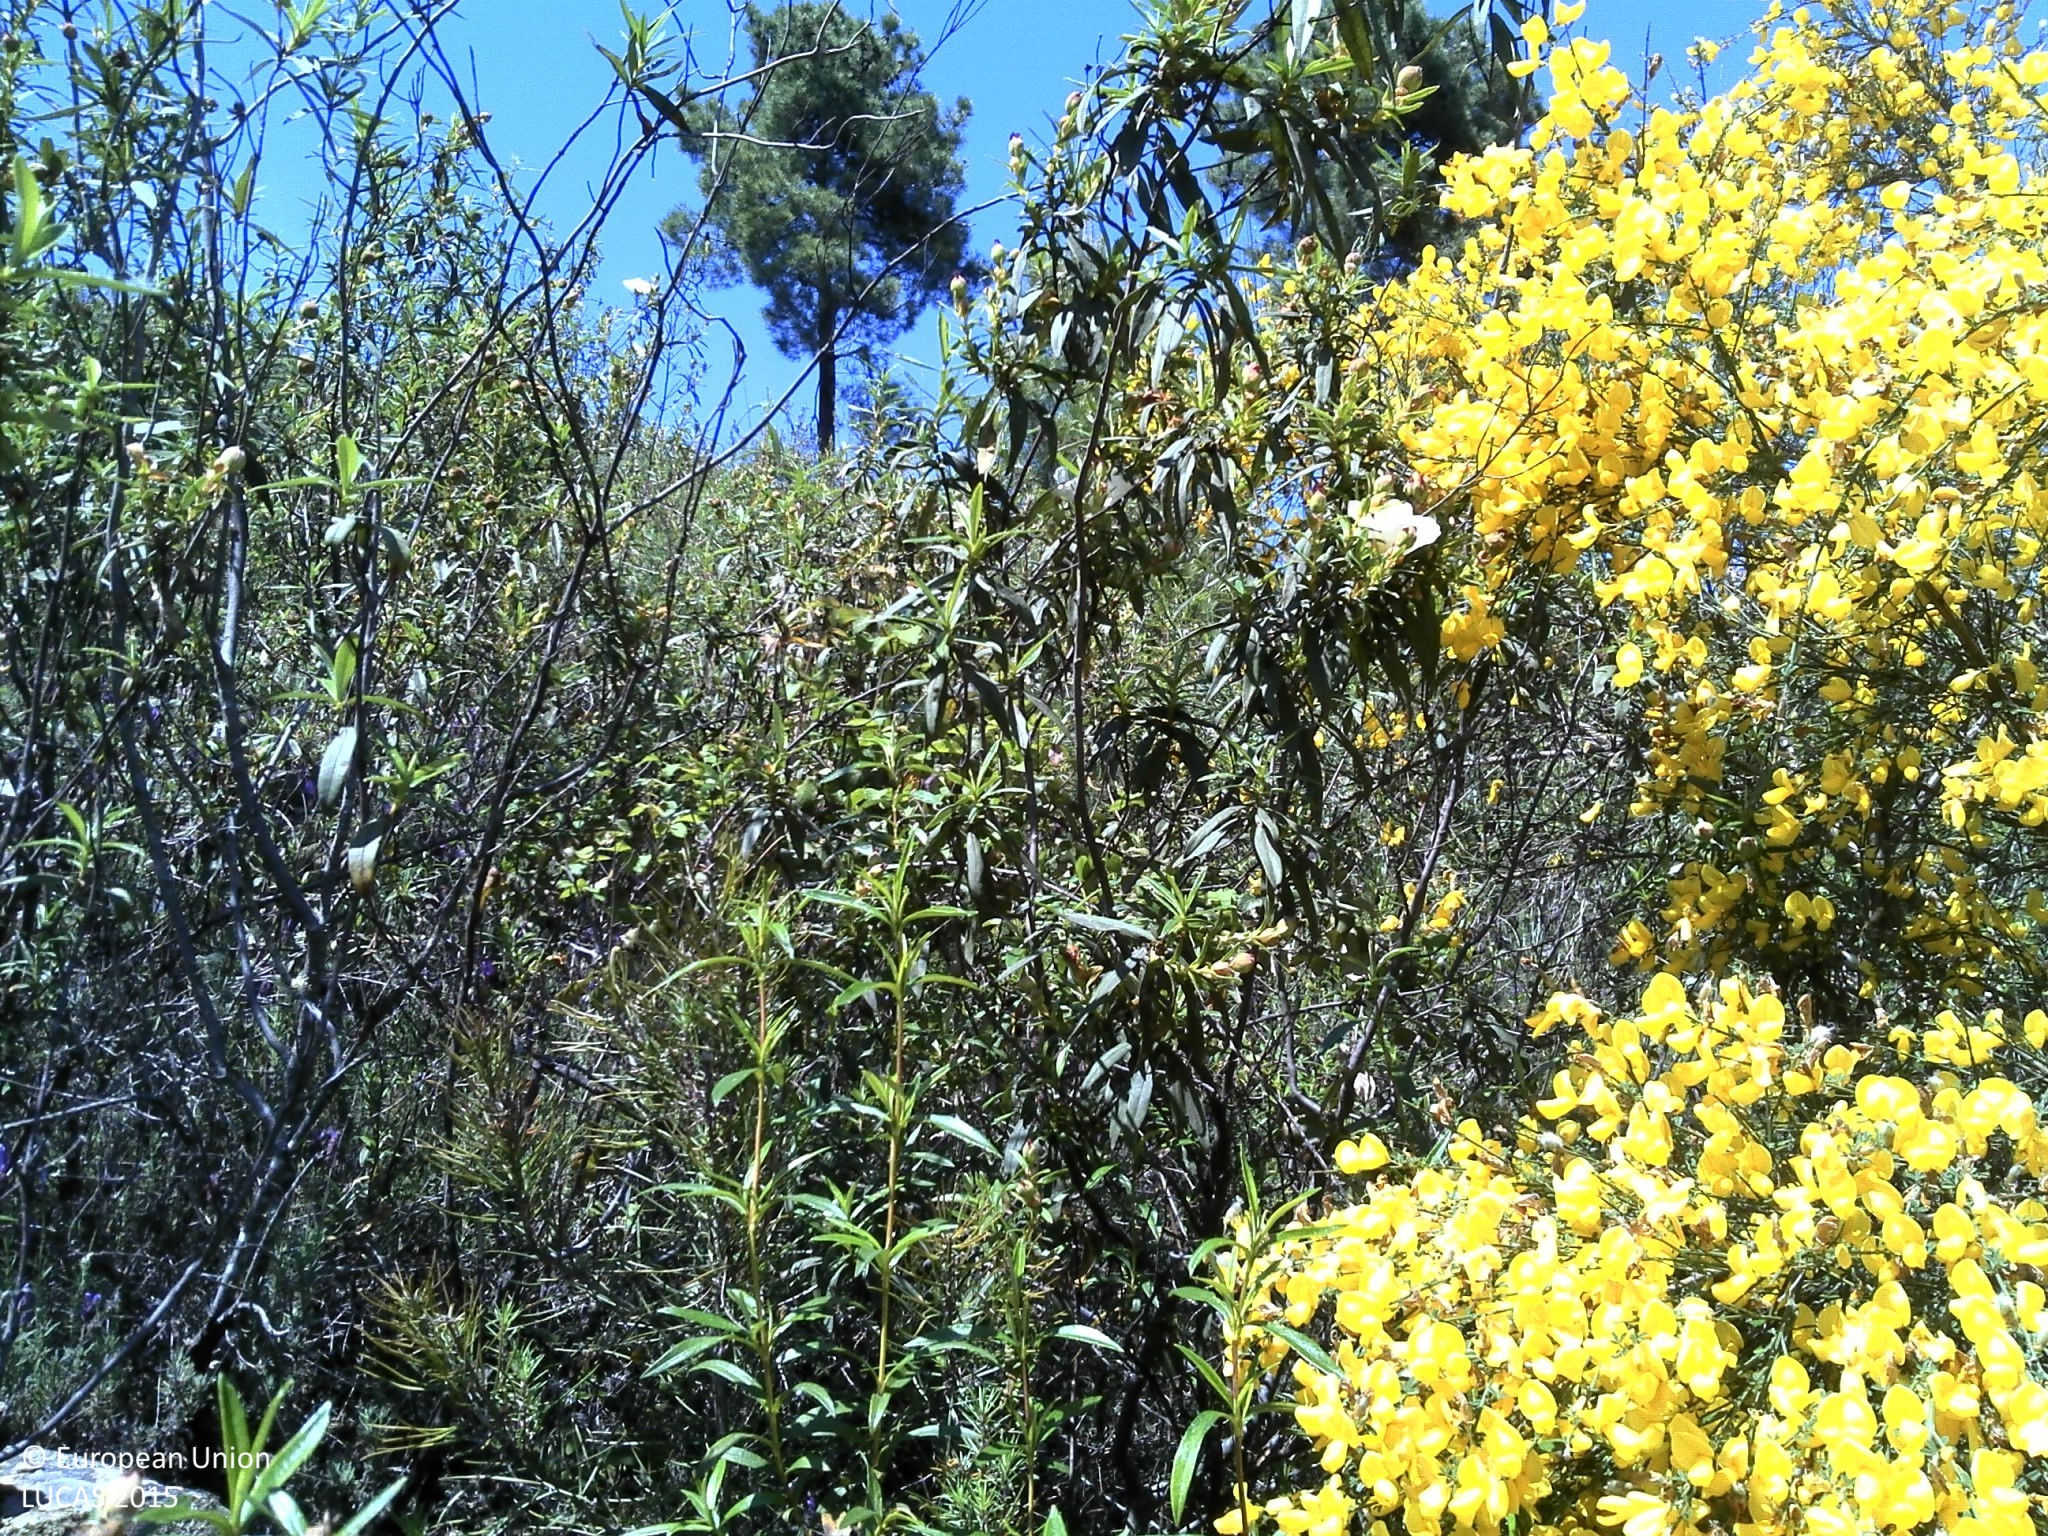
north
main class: Shrubland
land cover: Shrubland with sparse tree cover
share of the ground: > 75 %
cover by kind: shrubs 90 %, coniferous forest trees 5 %, unconsolidated bare surface 5 %
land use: Forestry
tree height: > 5 m
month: May
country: PT
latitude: 41.7380
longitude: -7.1102
